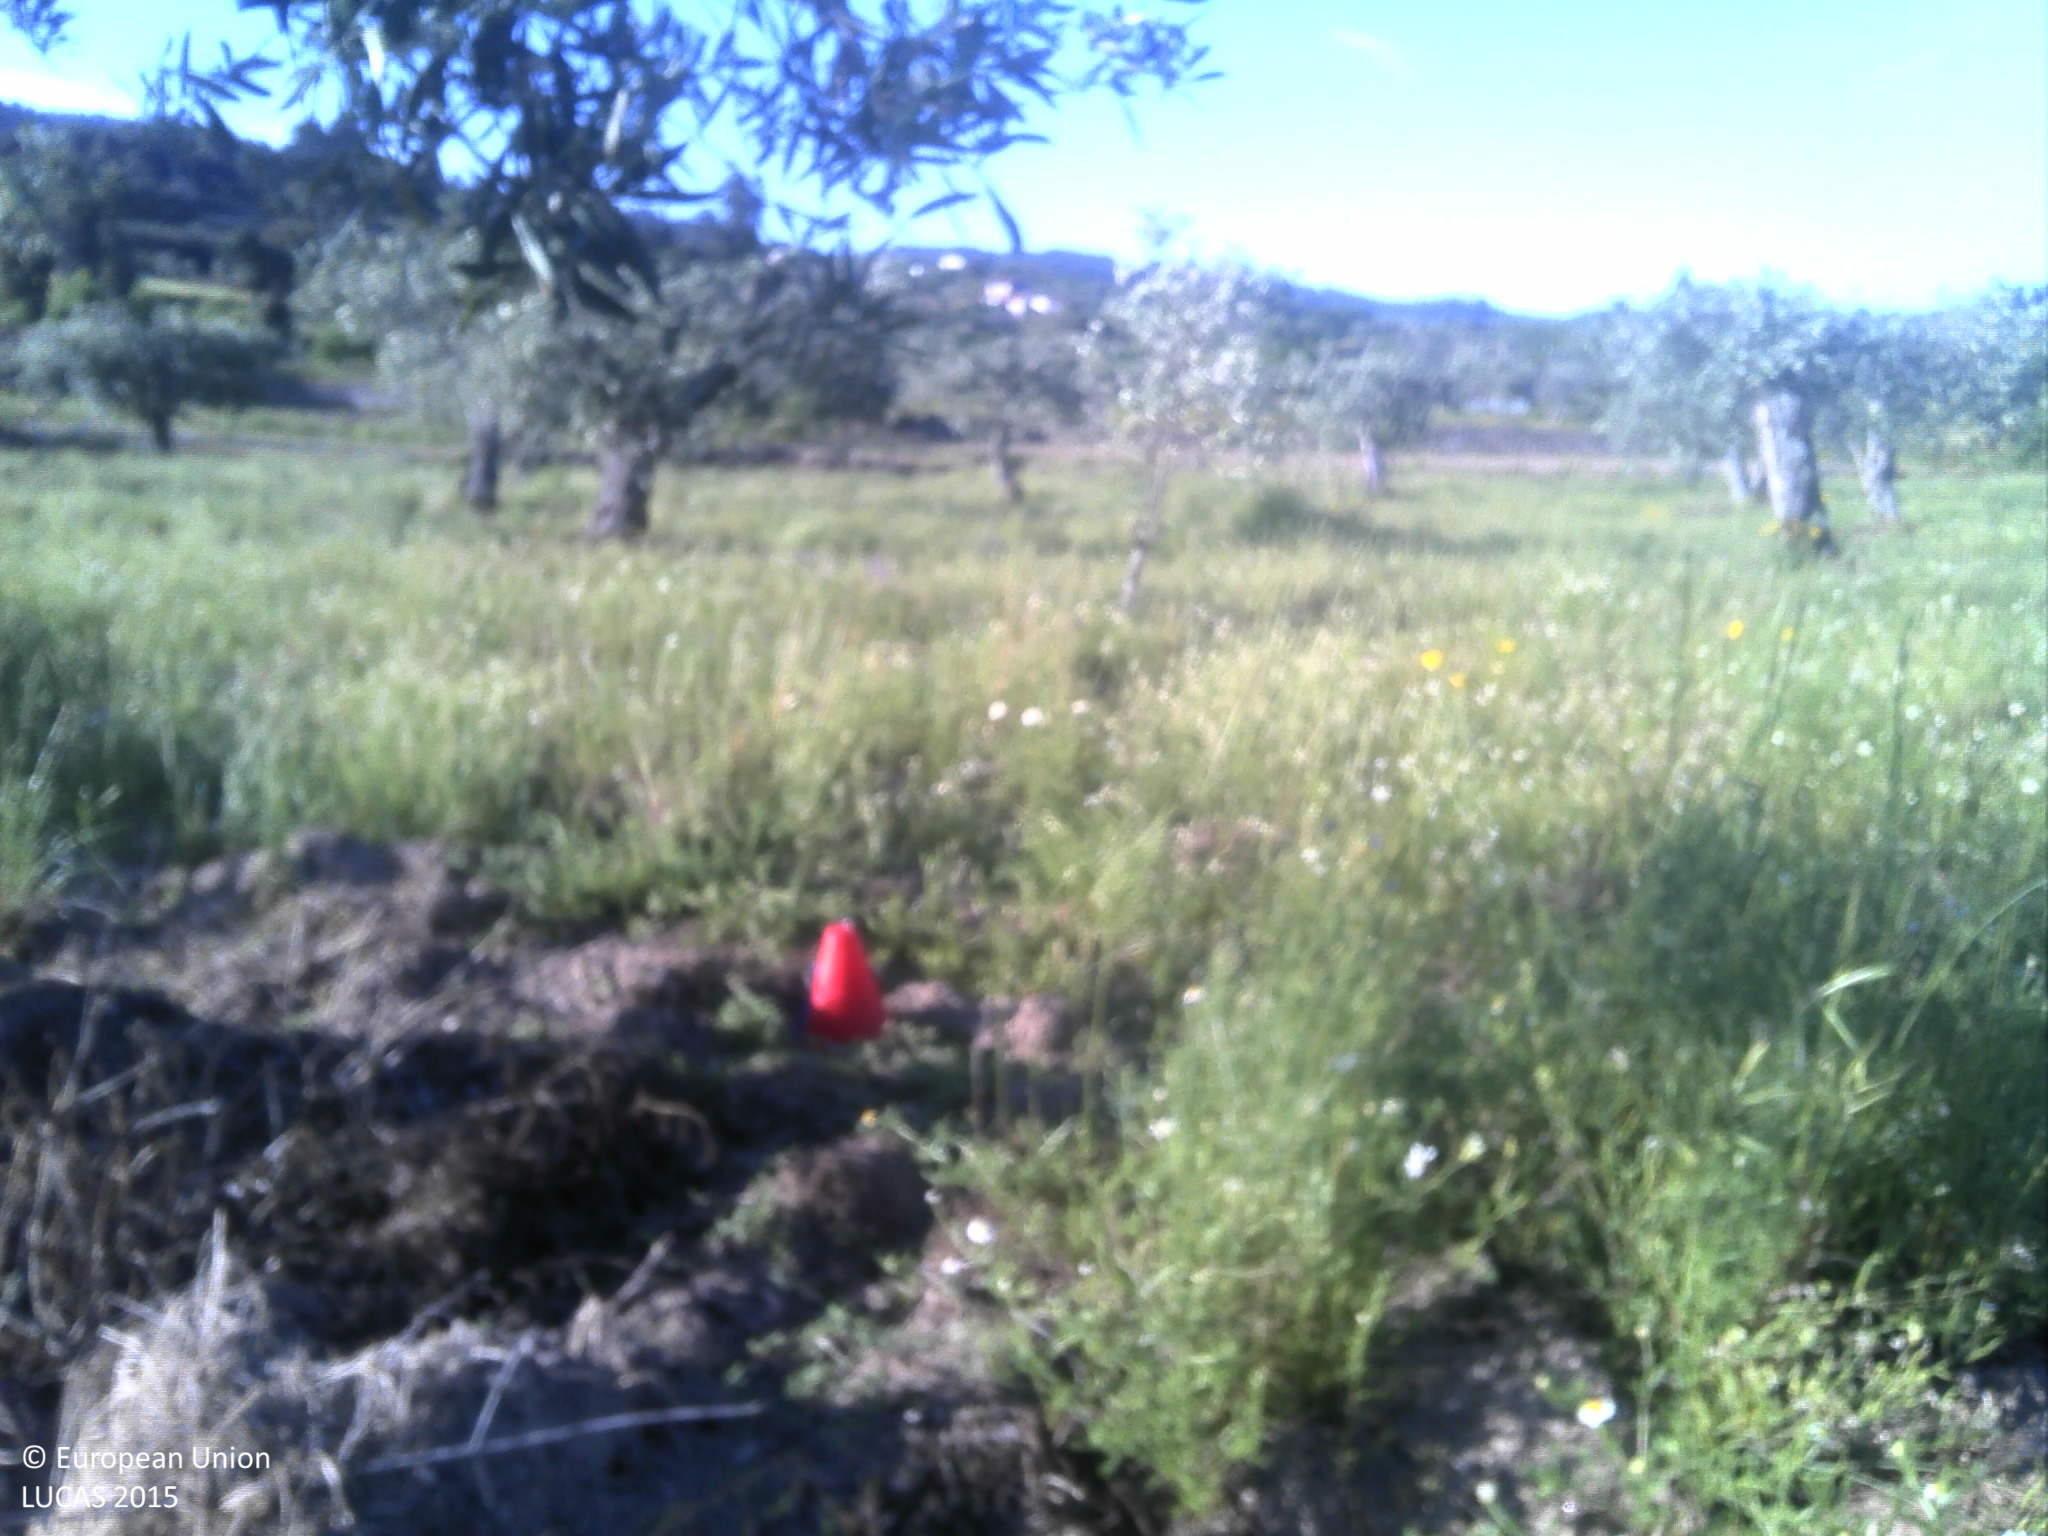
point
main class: Cropland
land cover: Olive groves
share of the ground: 25 - 50 %
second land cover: Grassland without tree/shrub cover
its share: 25 - 50 %
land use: Agriculture (excluding fallow land and kitchen gardens)
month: May
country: PT
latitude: 40.7174
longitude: -7.3592
